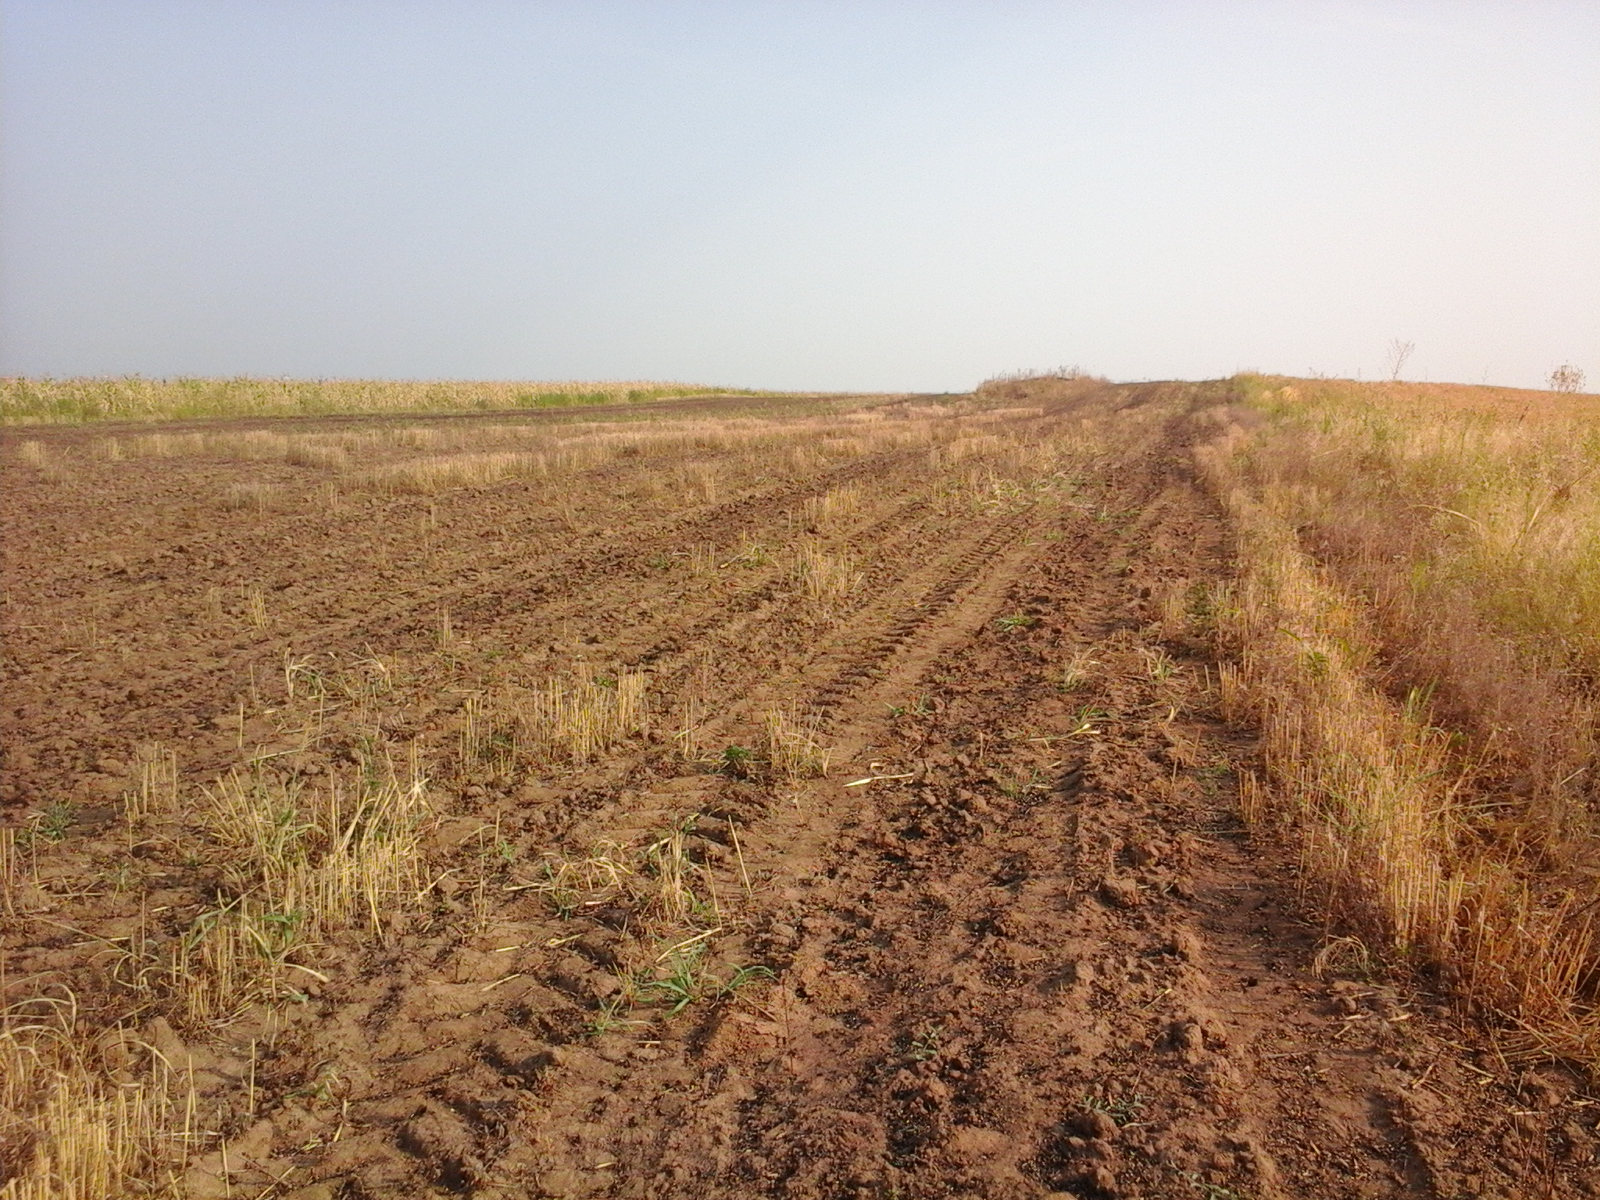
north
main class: Cropland
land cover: Barley
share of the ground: < 10 %
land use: Agriculture (excluding fallow land and kitchen gardens)
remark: Burnt area
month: August
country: RO
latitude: 44.2950
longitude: 22.7107
